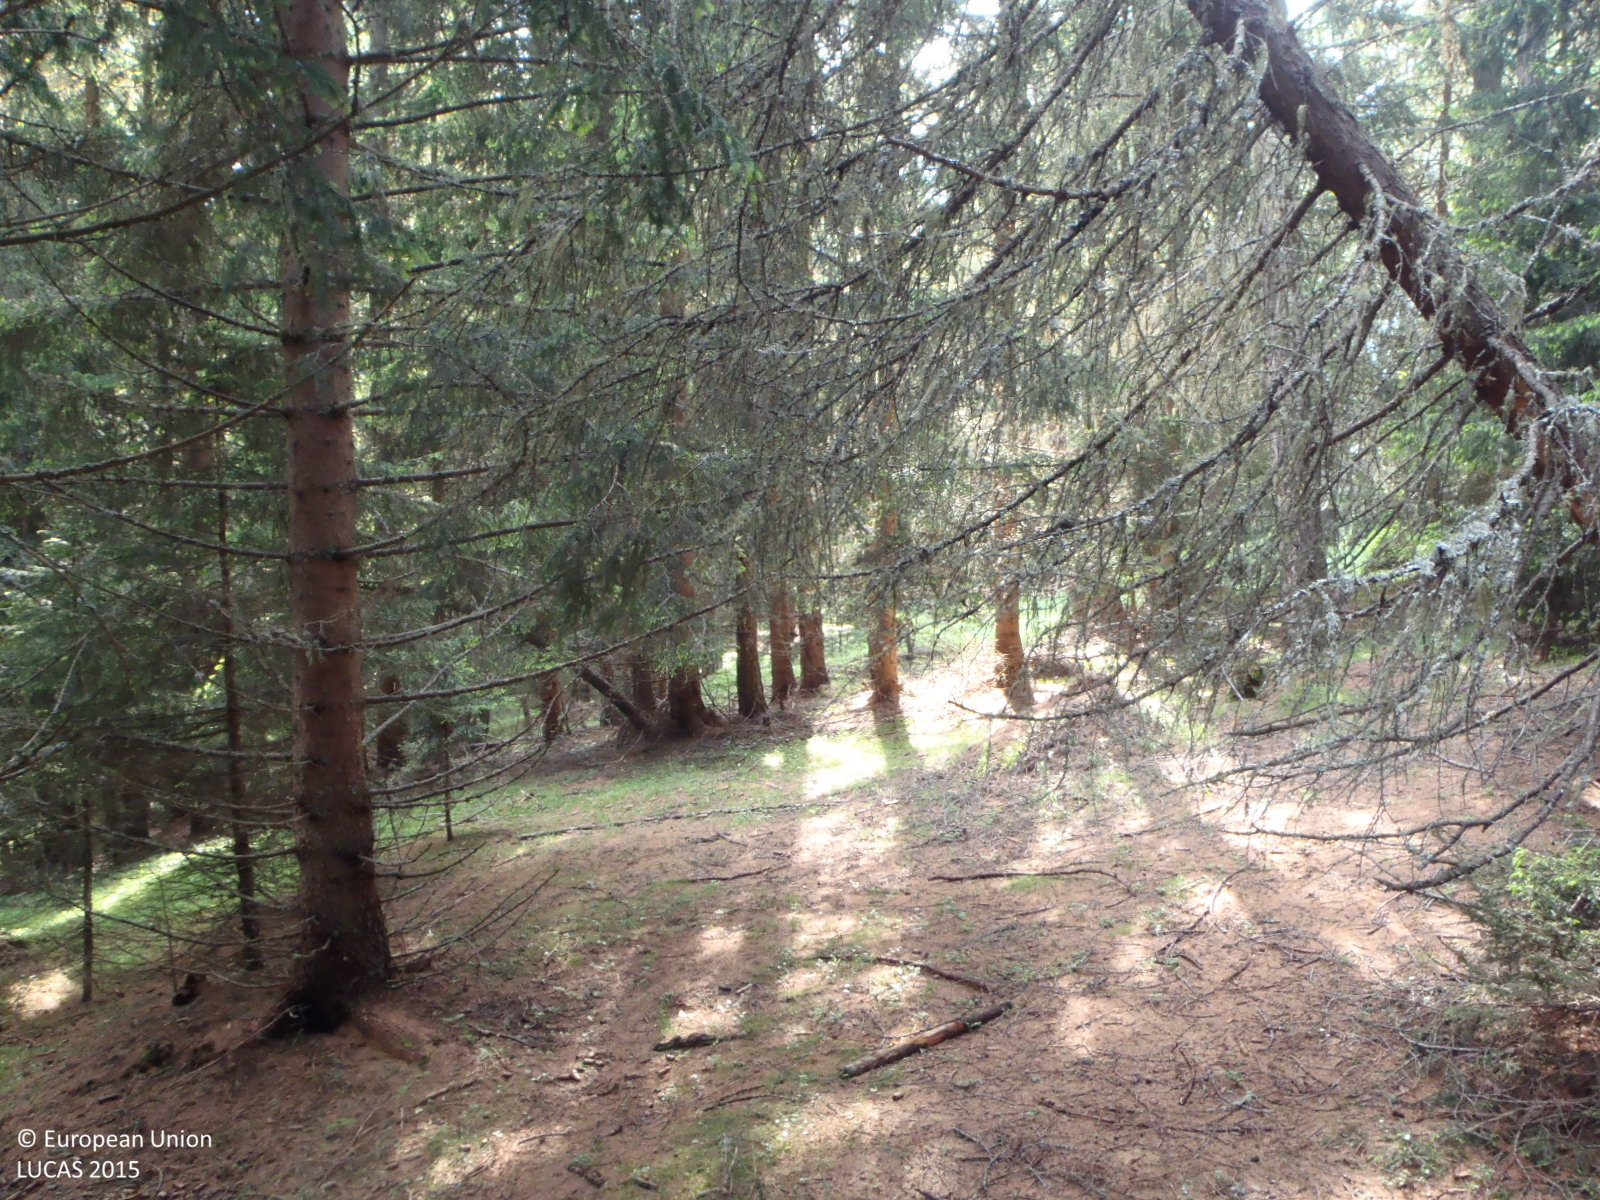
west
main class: Woodland
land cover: Other coniferous woodland
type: alpine coniferous forest
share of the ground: > 75 %
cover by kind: coniferous forest trees 100 %
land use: Forestry
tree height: > 5 m
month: June
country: AT
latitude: 47.1071
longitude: 13.9645
